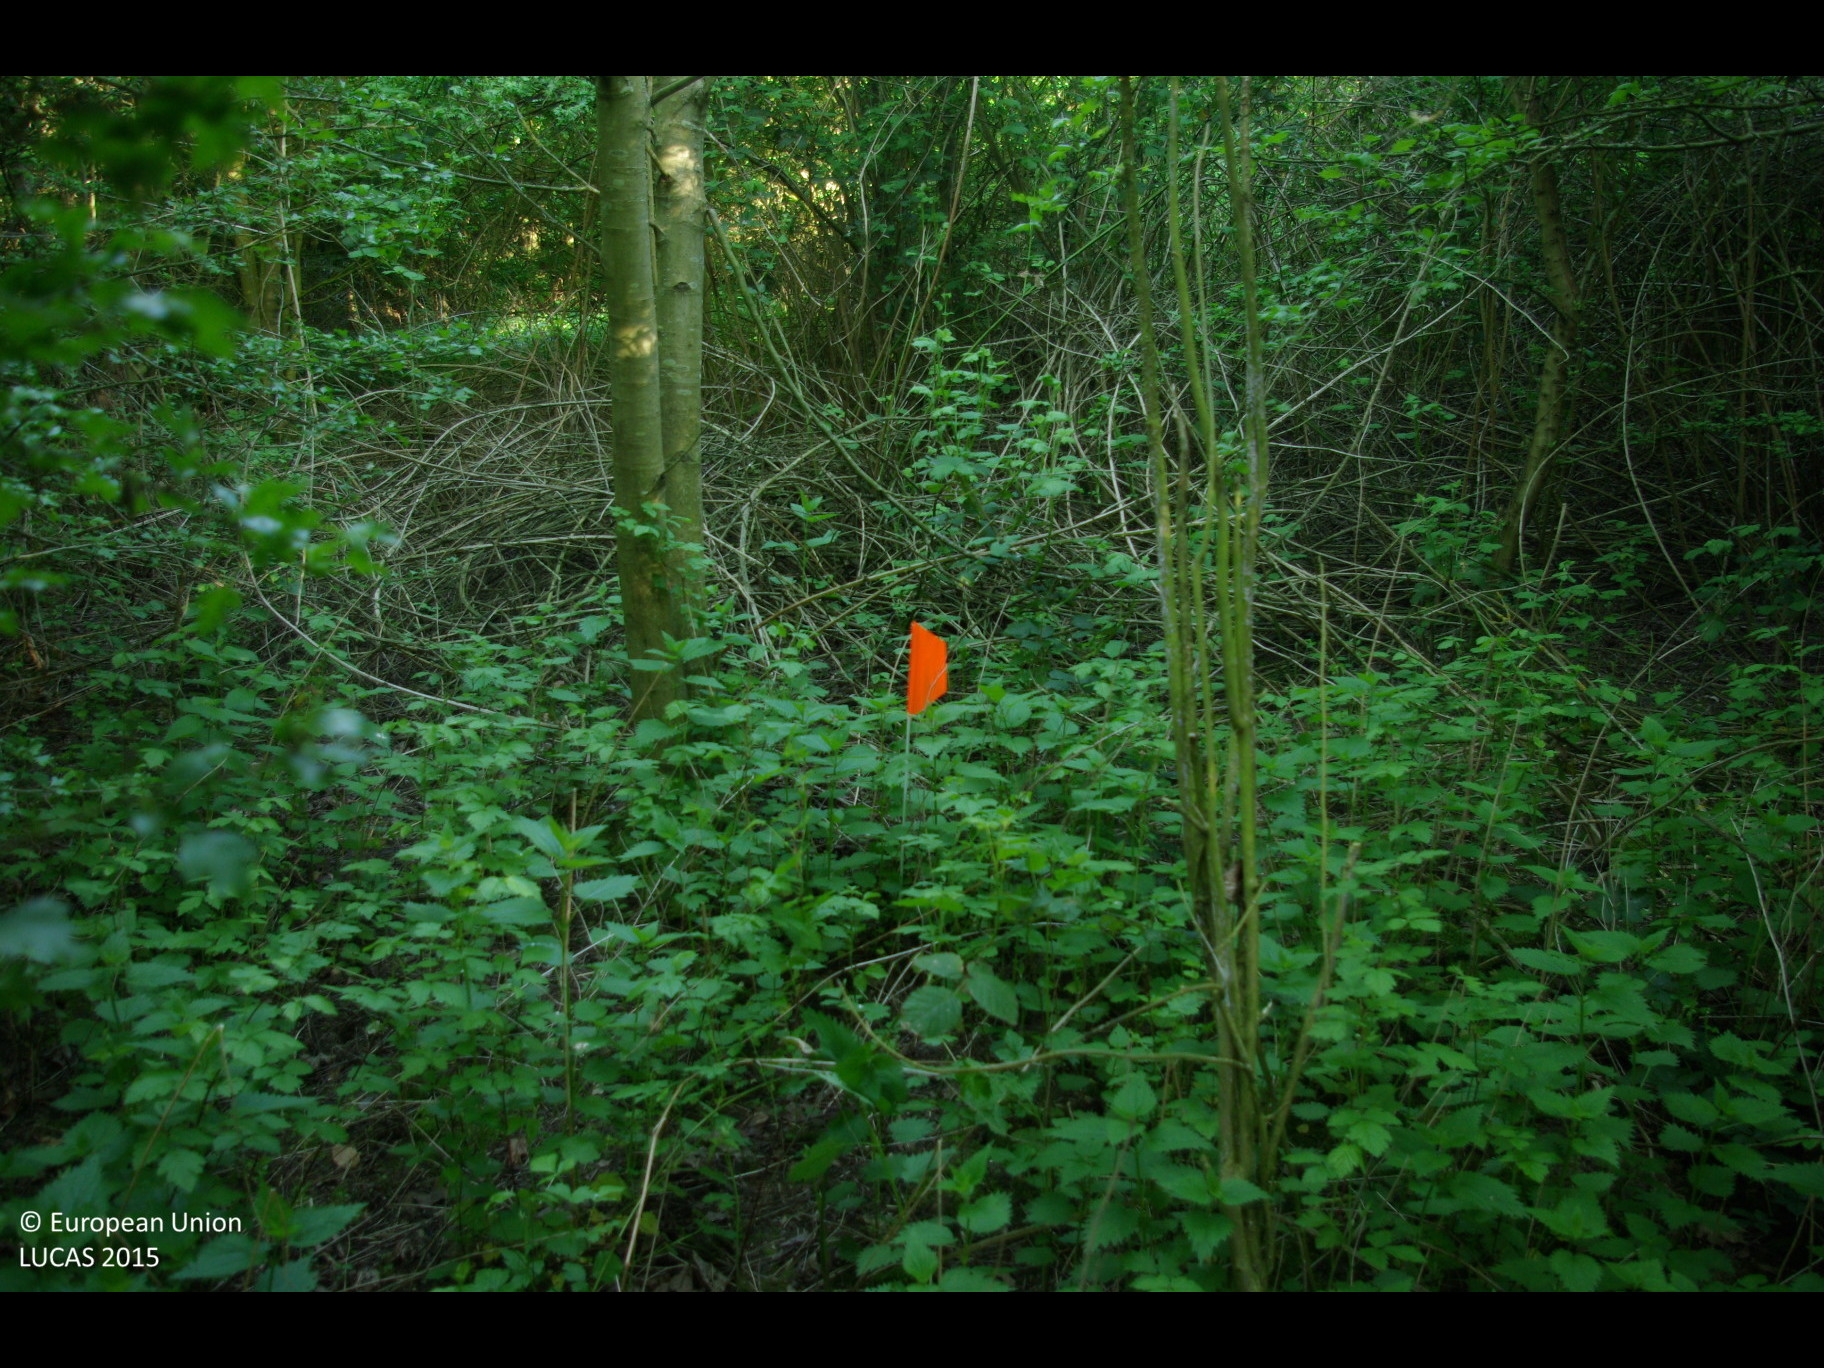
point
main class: Shrubland
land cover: Shrubland with sparse tree cover
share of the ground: > 75 %
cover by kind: shrubs 80 %, herbaceous plants 10 %, broadleaved forest trees 5 %, unconsolidated bare surface 5 %
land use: Semi-natural and natural areas not in use
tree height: < 5 m
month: May
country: DE
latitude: 54.3684
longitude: 10.9999
